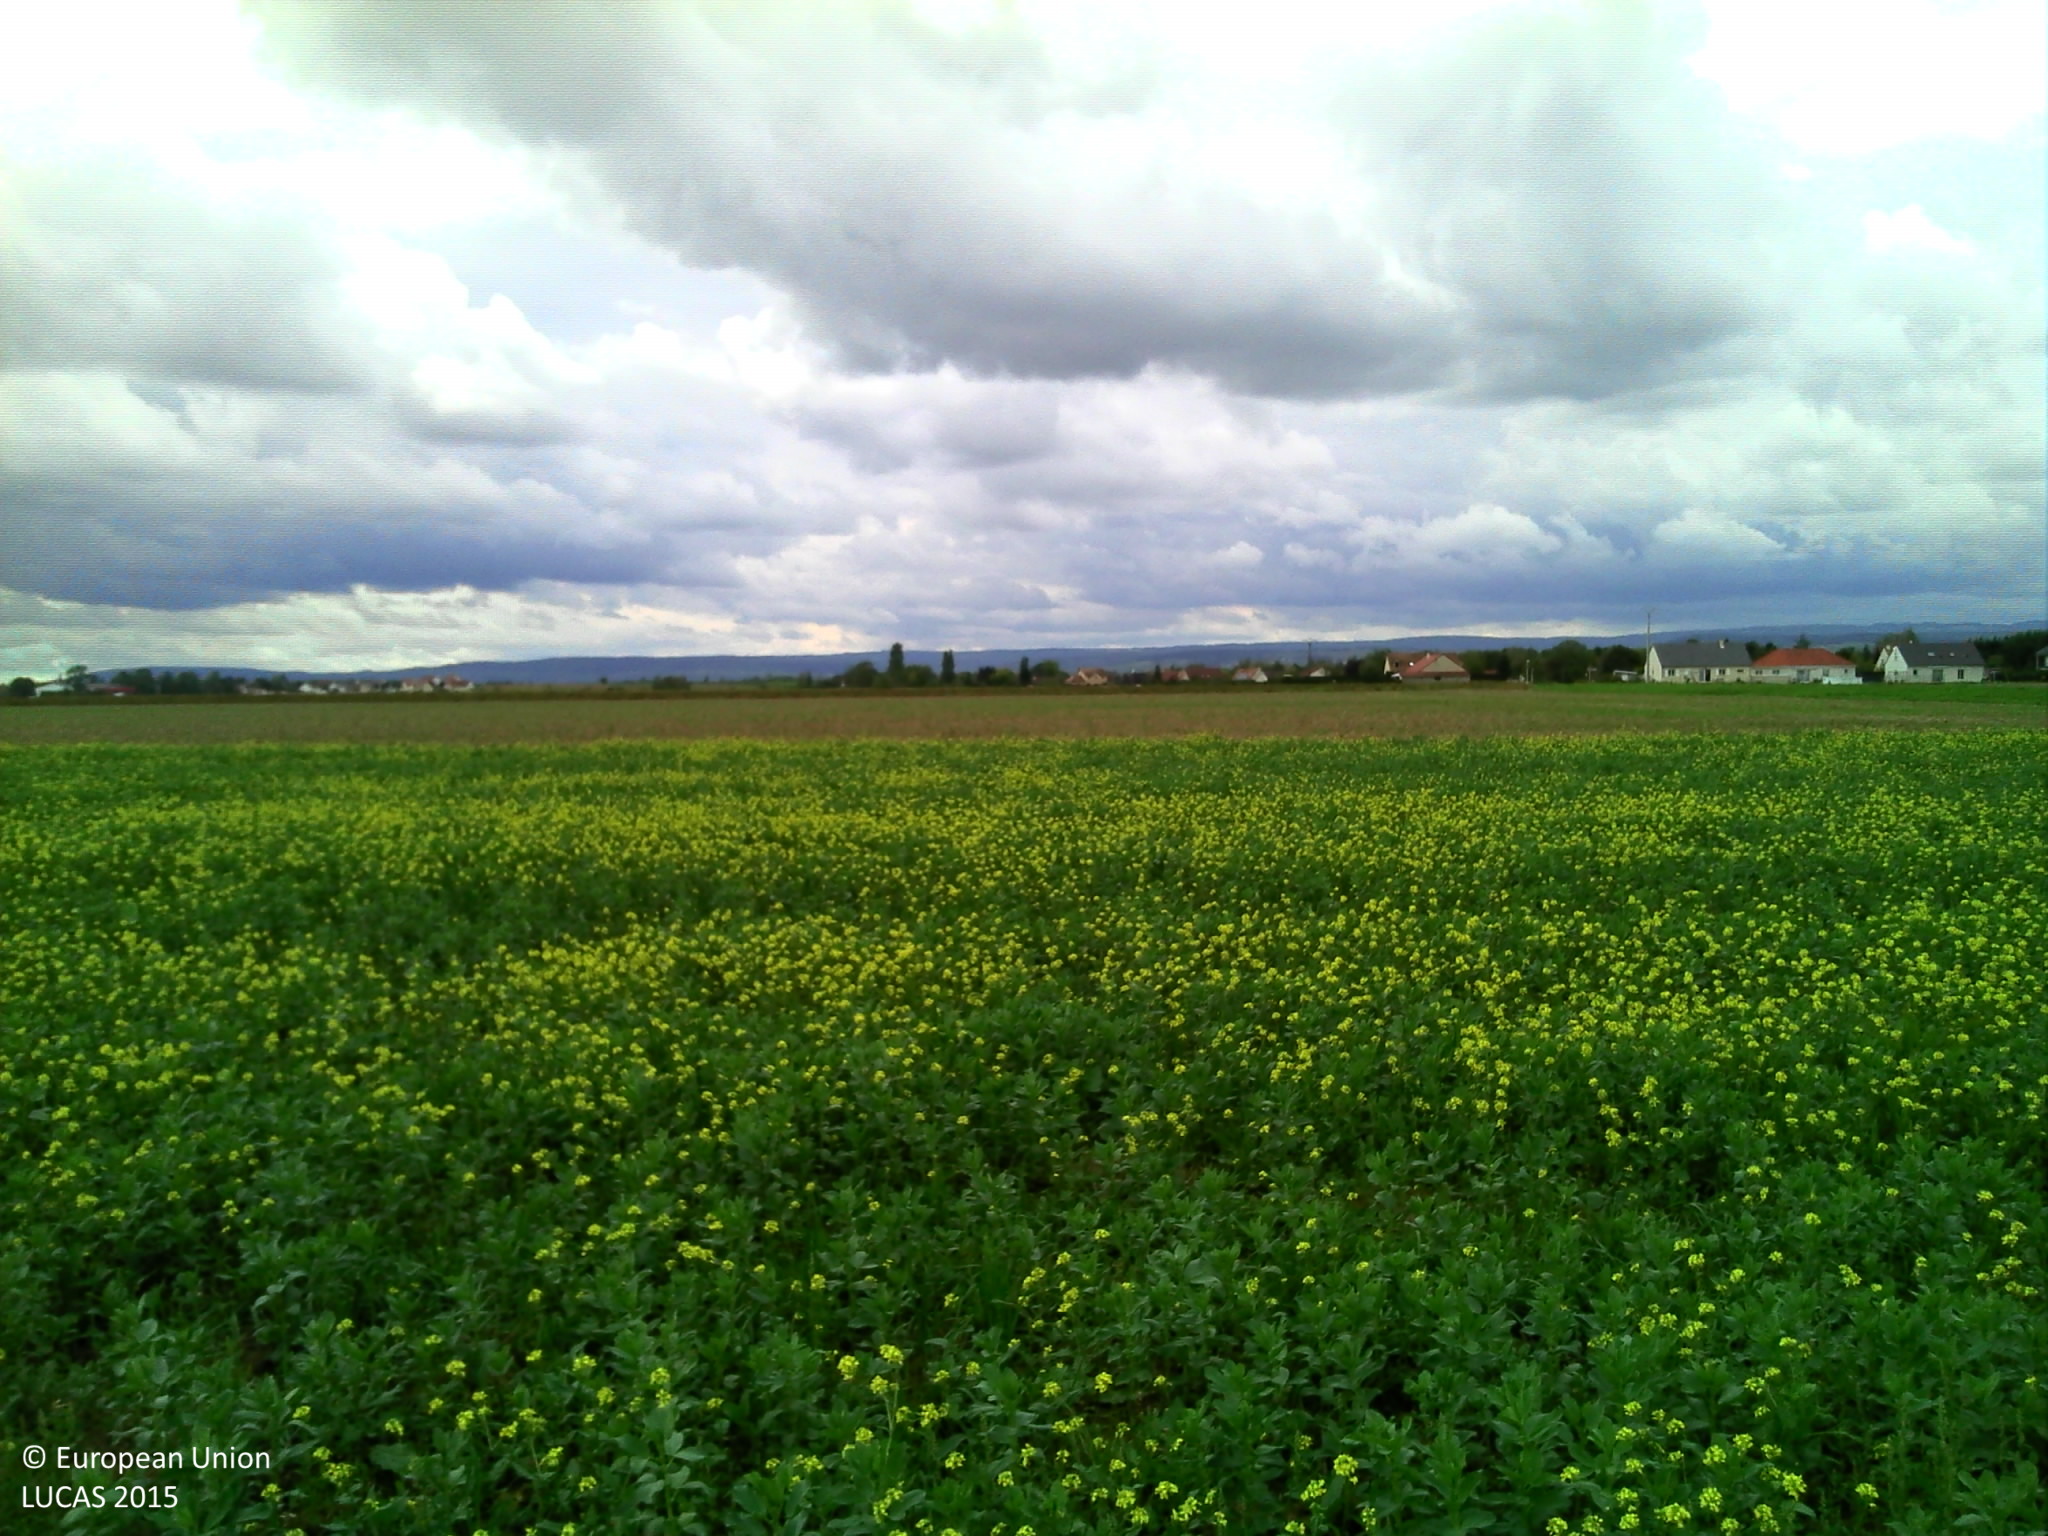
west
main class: Cropland
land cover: Other fibre and oleaginous crops
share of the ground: > 75 %
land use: Agriculture (excluding fallow land and kitchen gardens)
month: September
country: FR
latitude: 46.9880
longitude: 4.9126
